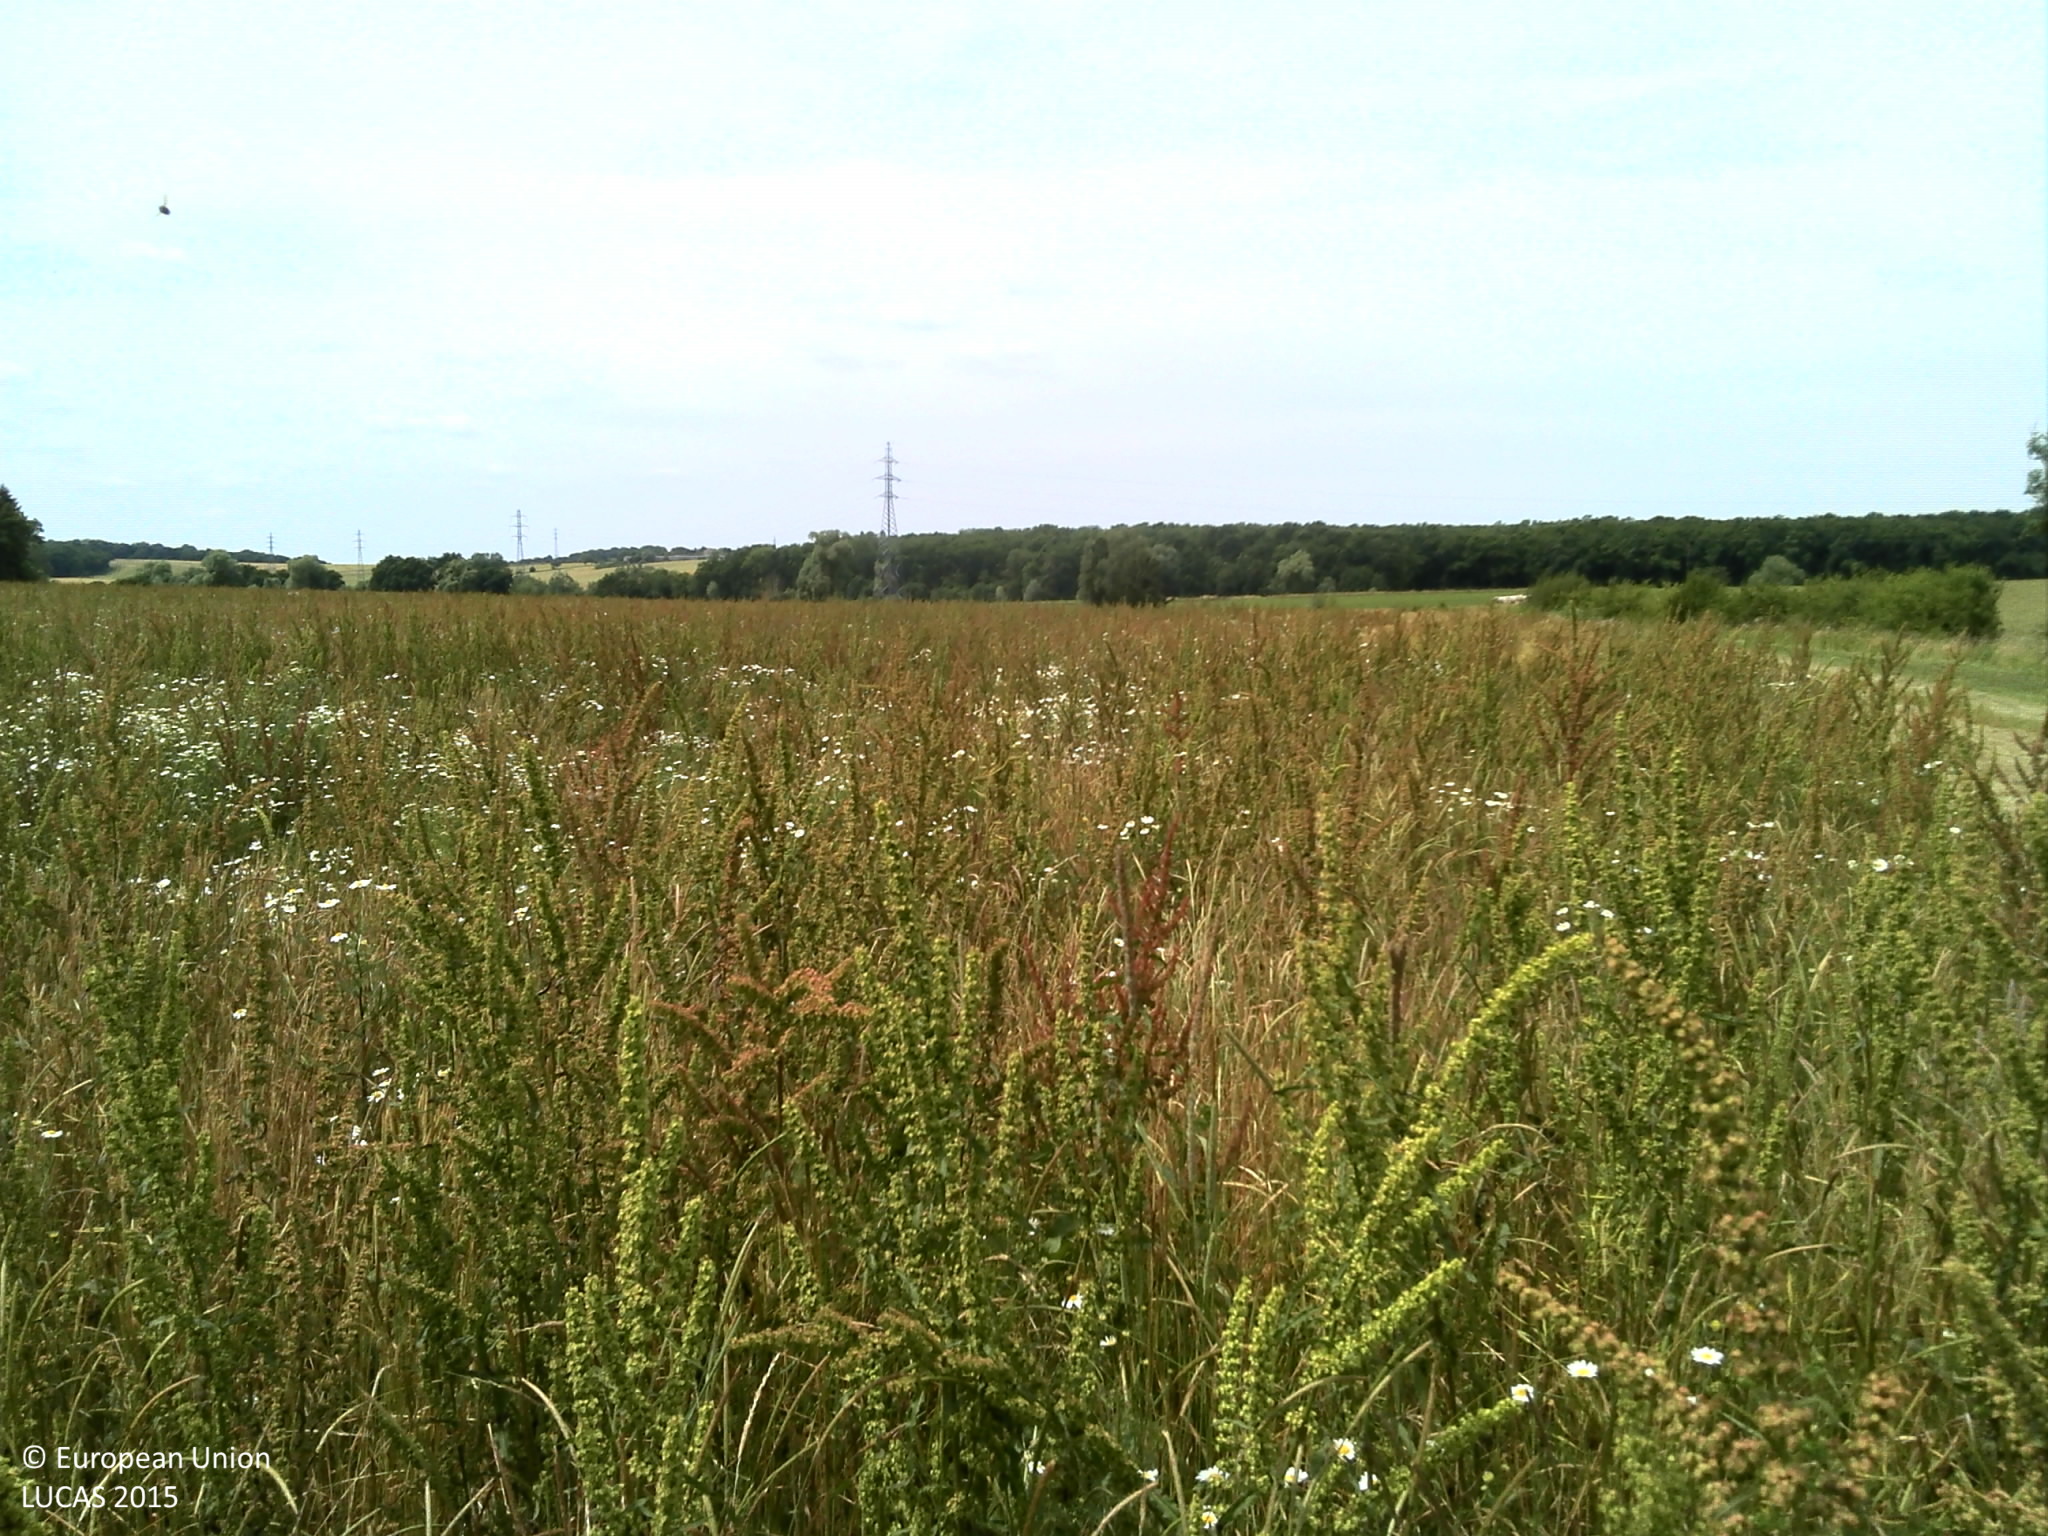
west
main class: Grassland
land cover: Grassland without tree/shrub cover
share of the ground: > 75 %
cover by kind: herbaceous plants 100 %
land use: Agriculture (excluding fallow land and kitchen gardens)
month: June
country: FR
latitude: 49.2943
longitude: 6.2459
